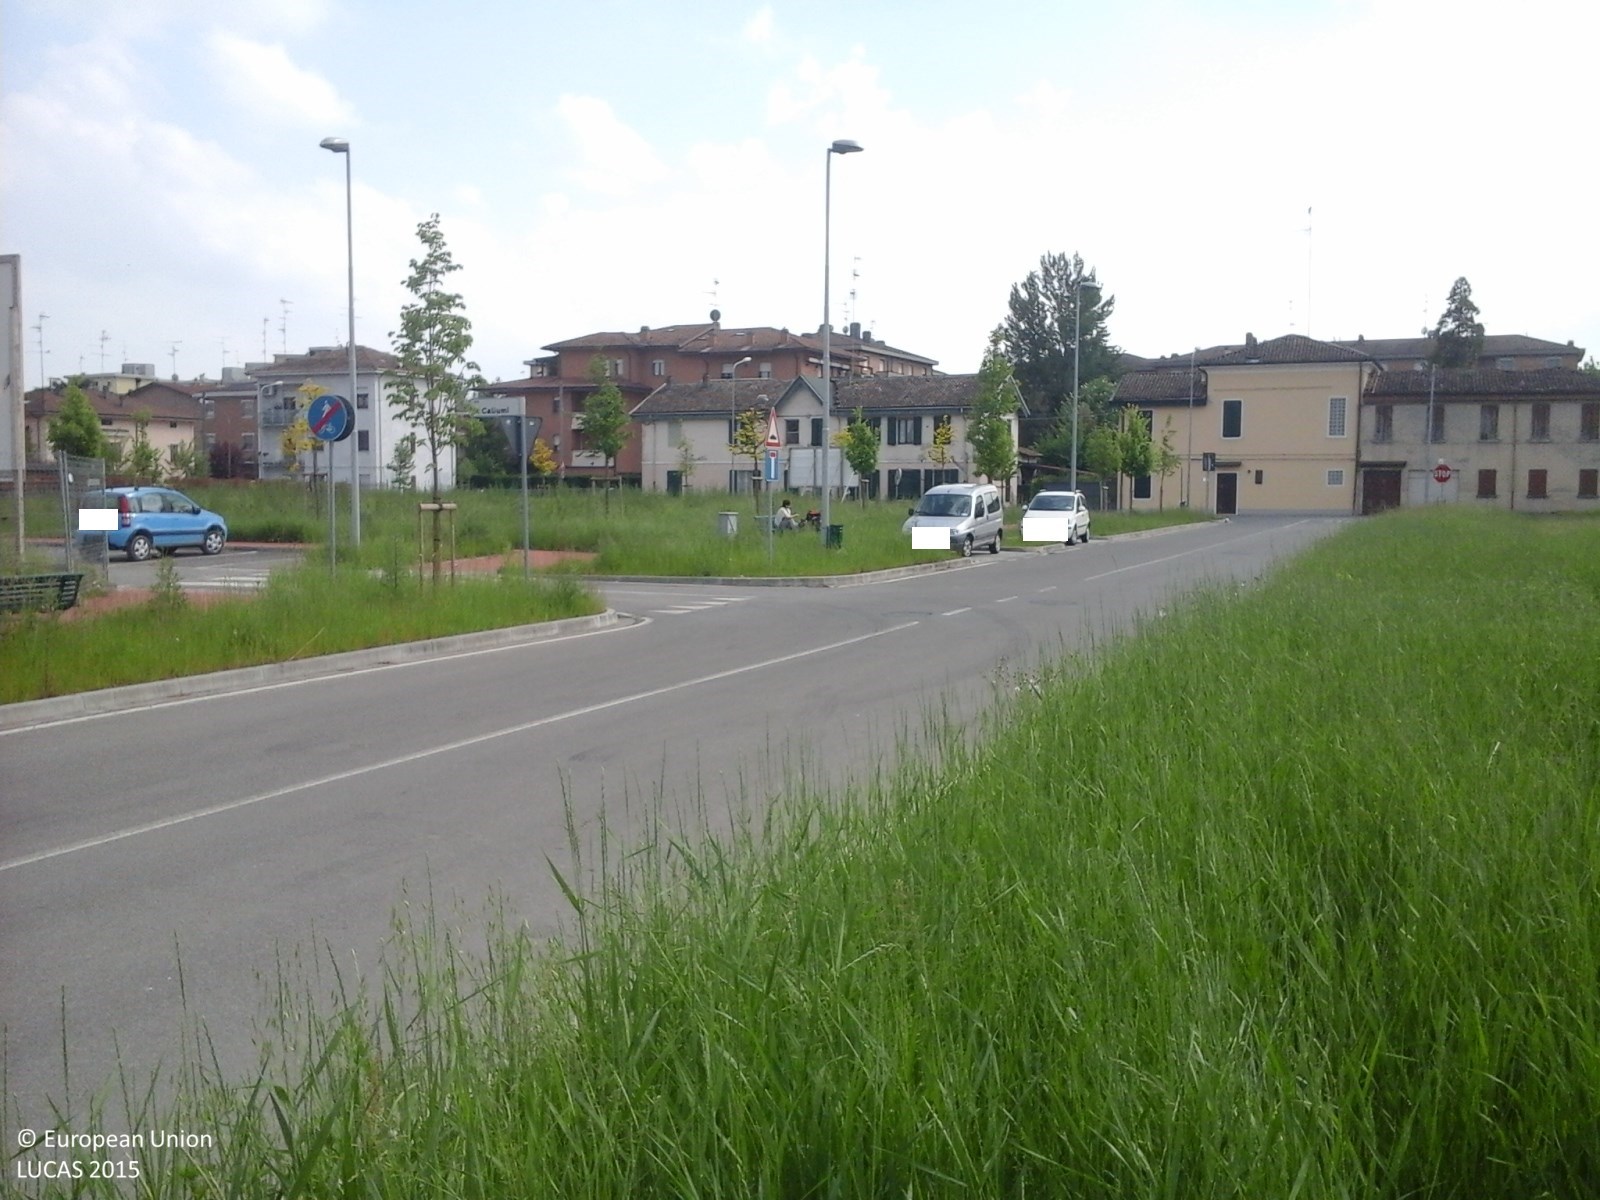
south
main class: Grassland
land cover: Spontaneously vegetated surfaces
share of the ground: 50 - 75 %
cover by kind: herbaceous plants 100 %
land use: Agriculture (excluding fallow land and kitchen gardens)
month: April
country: IT
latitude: 44.7795
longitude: 10.8954
